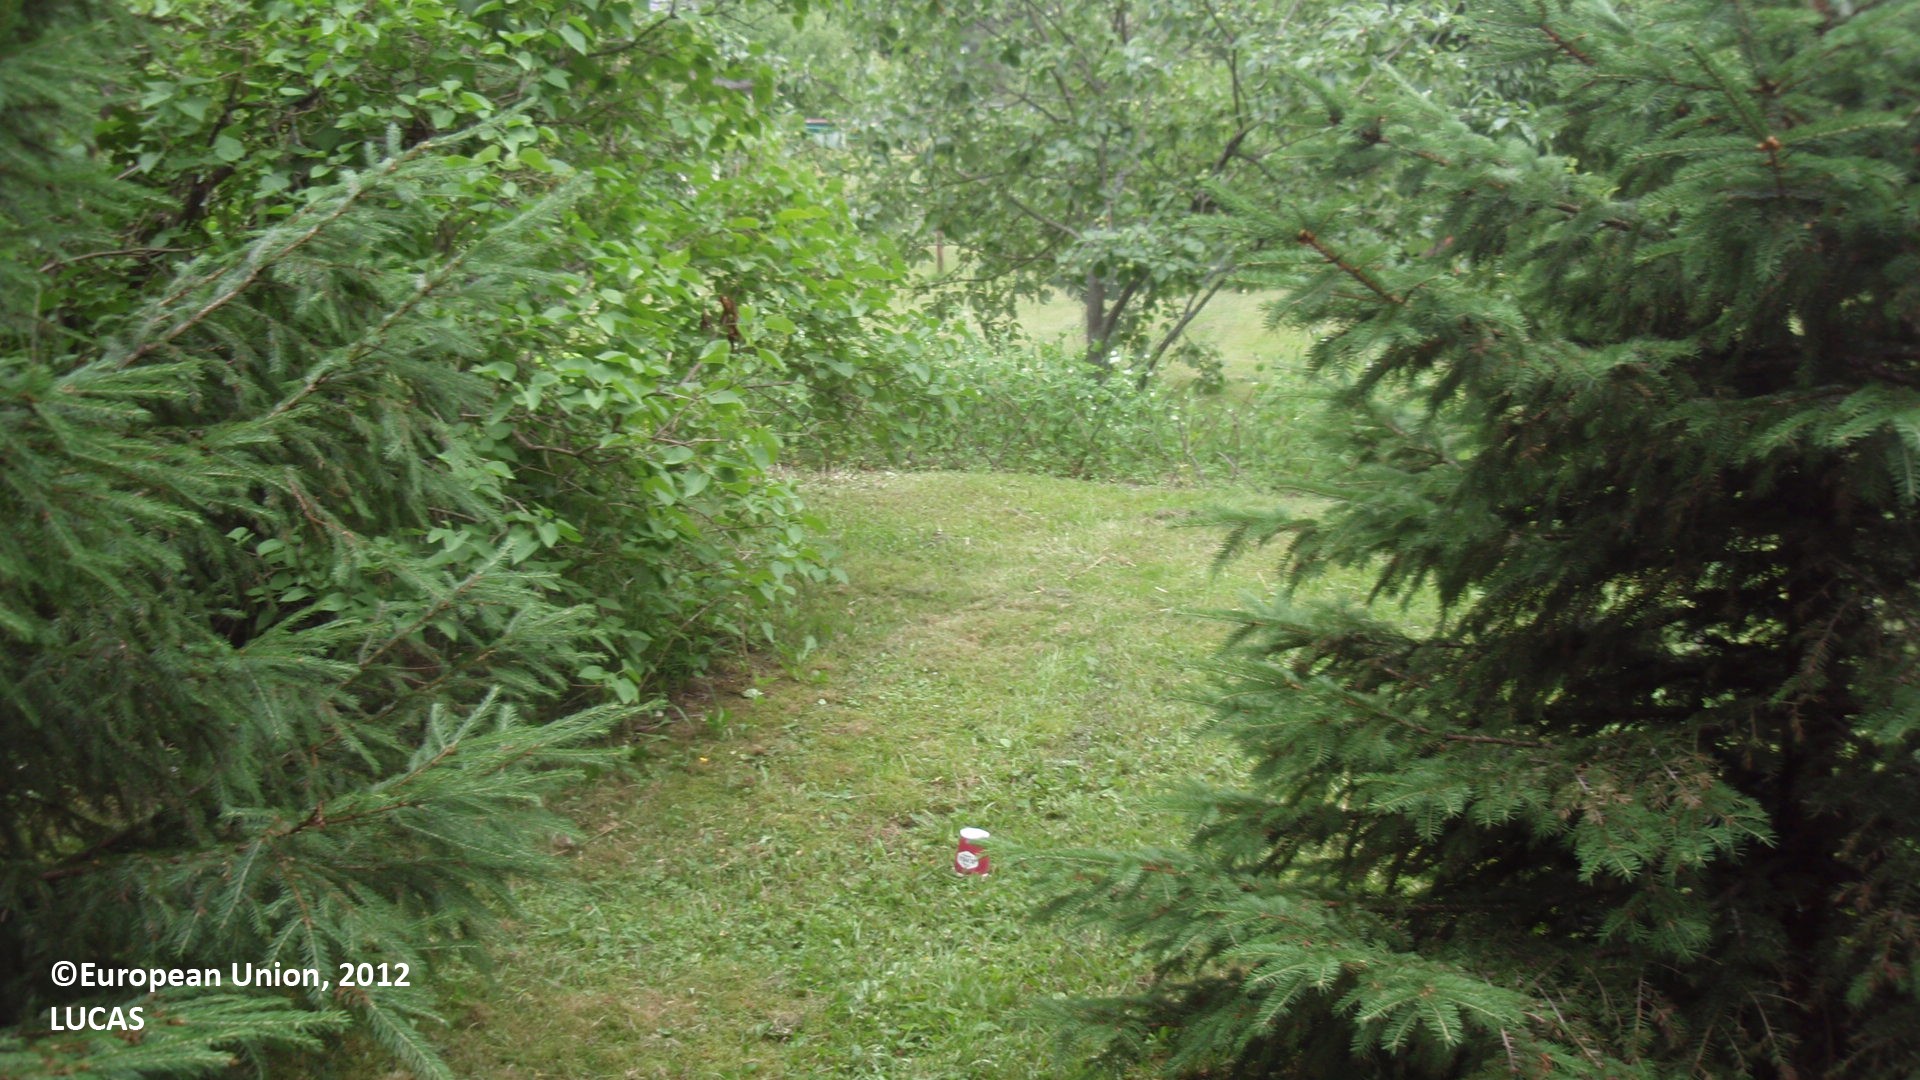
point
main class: Grassland
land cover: Grassland with sparse tree/shrub cover
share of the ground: > 75 %
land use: Residential
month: July
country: FI
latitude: 61.1850
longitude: 28.8069
